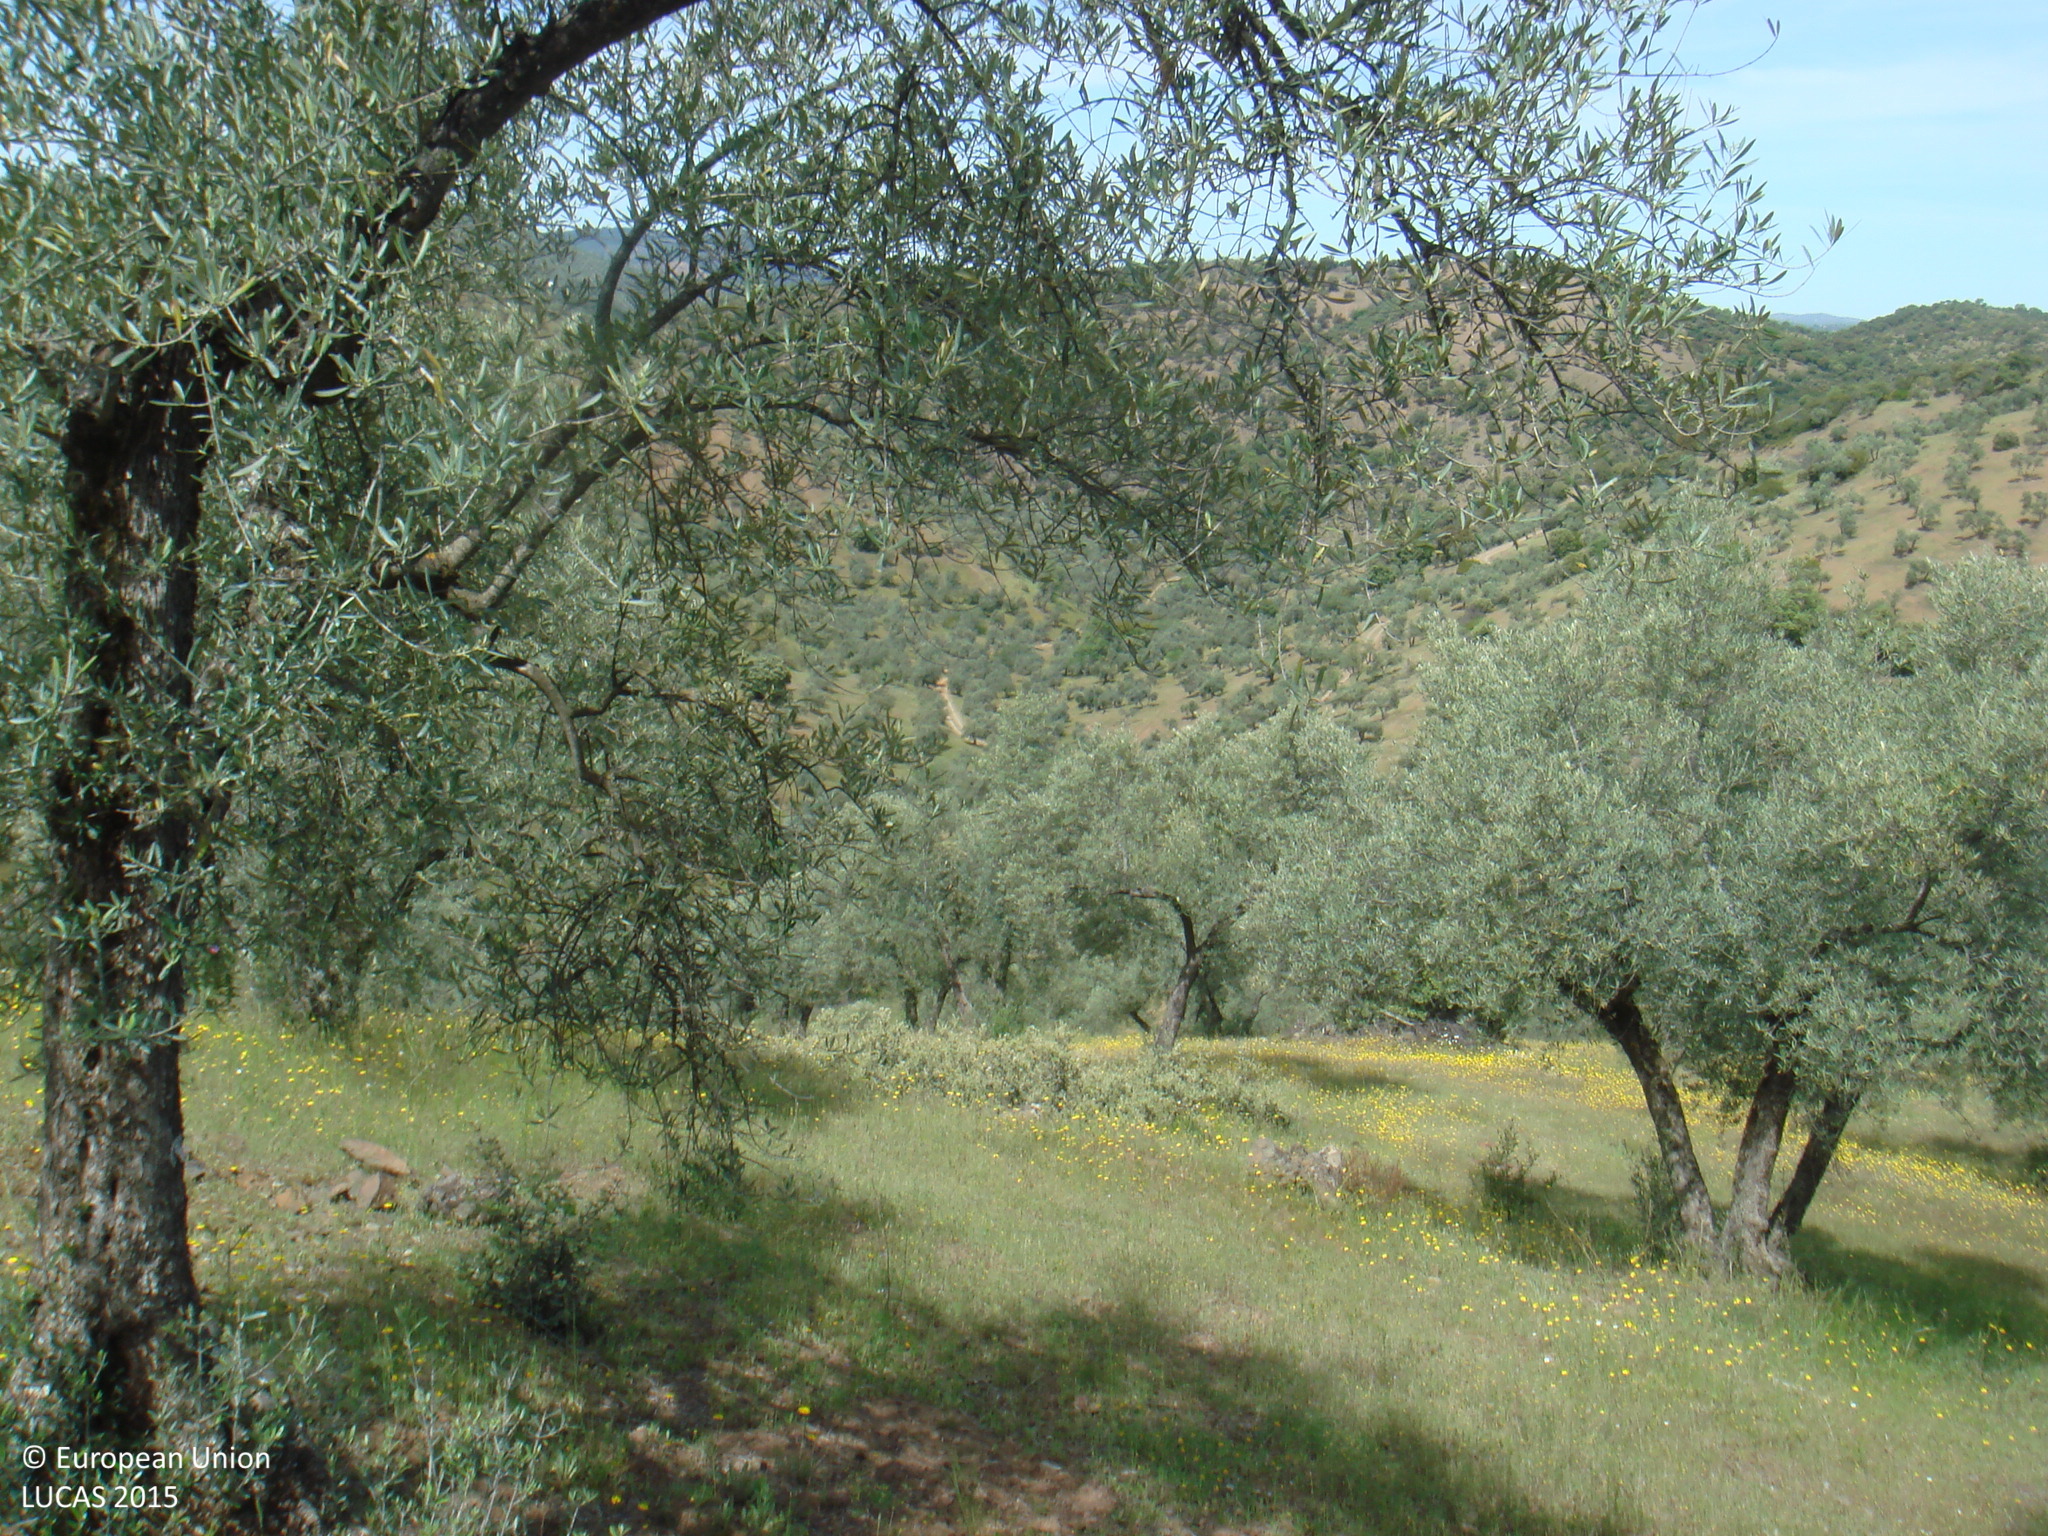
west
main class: Cropland
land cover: Olive groves
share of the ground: 25 - 50 %
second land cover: Spontaneously vegetated surfaces
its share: > 75 %
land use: Agriculture (excluding fallow land and kitchen gardens)
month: April
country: ES
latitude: 38.1604
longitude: -4.7064
